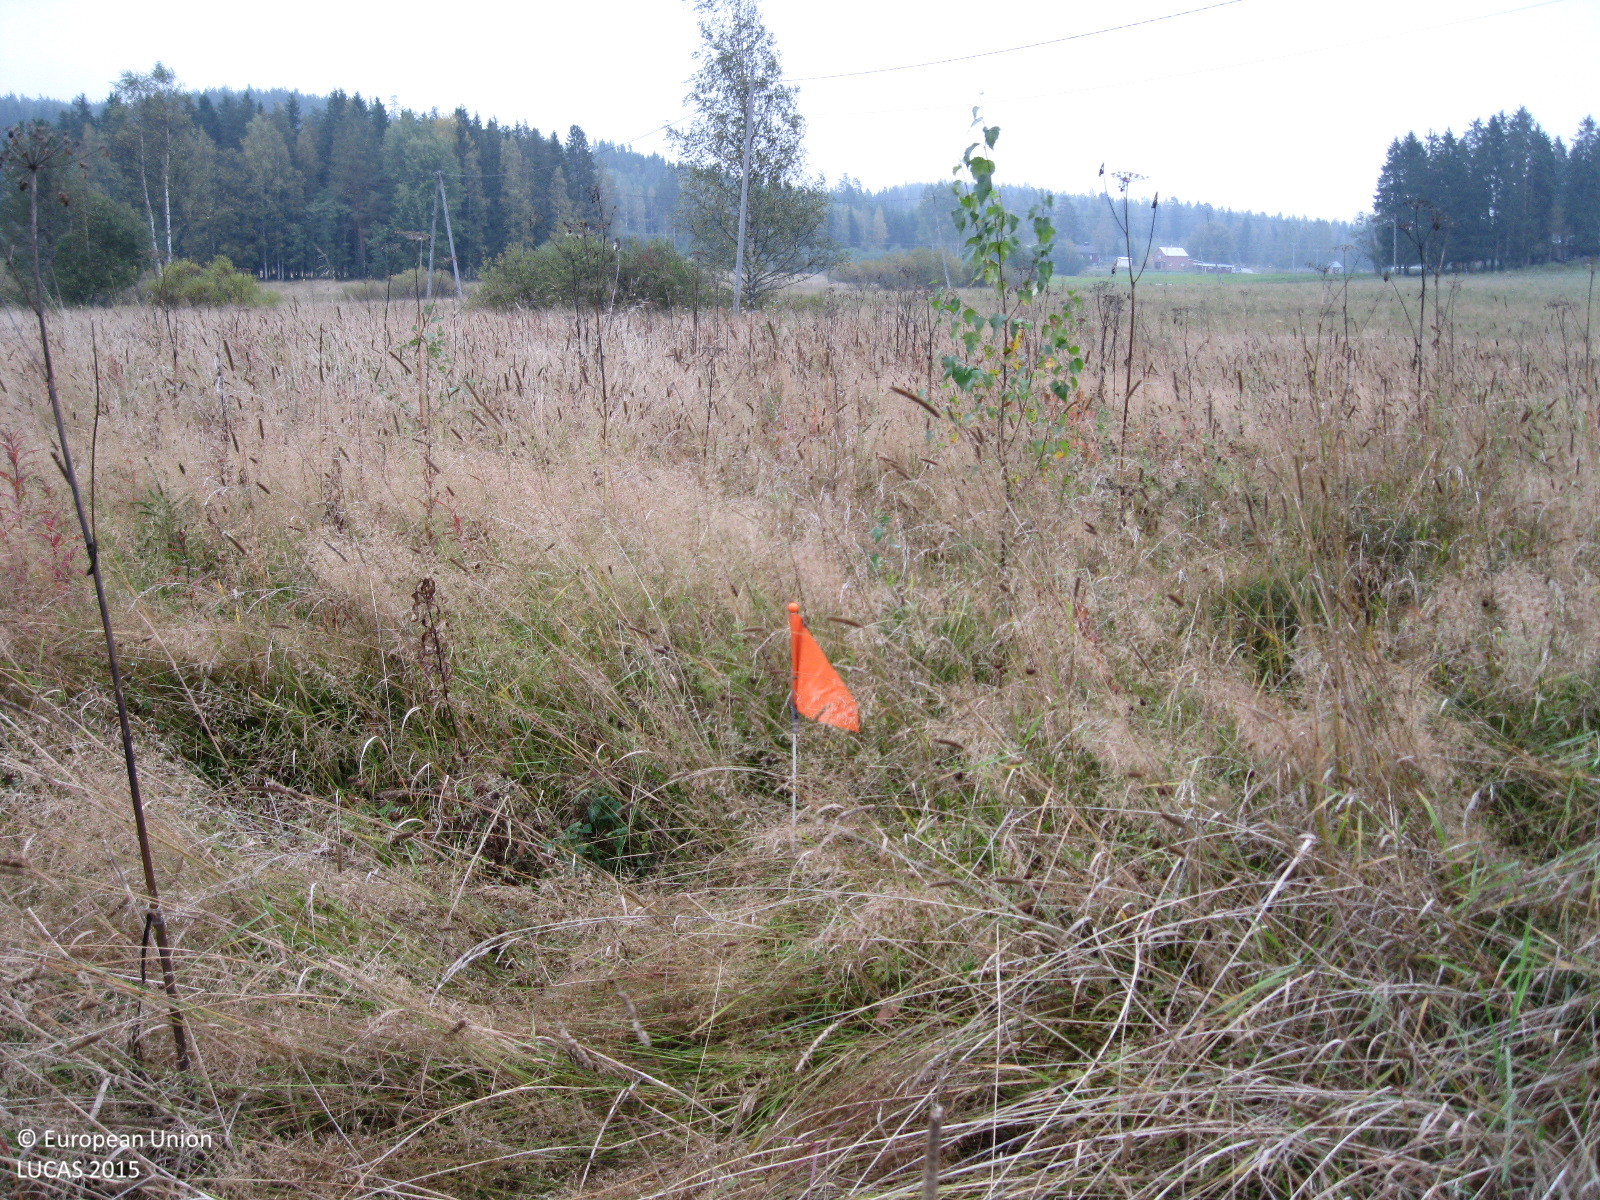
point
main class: Grassland
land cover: Spontaneously vegetated surfaces
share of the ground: > 75 %
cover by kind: herbaceous plants 100 %
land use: Fallow land
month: September
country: FI
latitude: 60.8712
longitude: 24.9006
